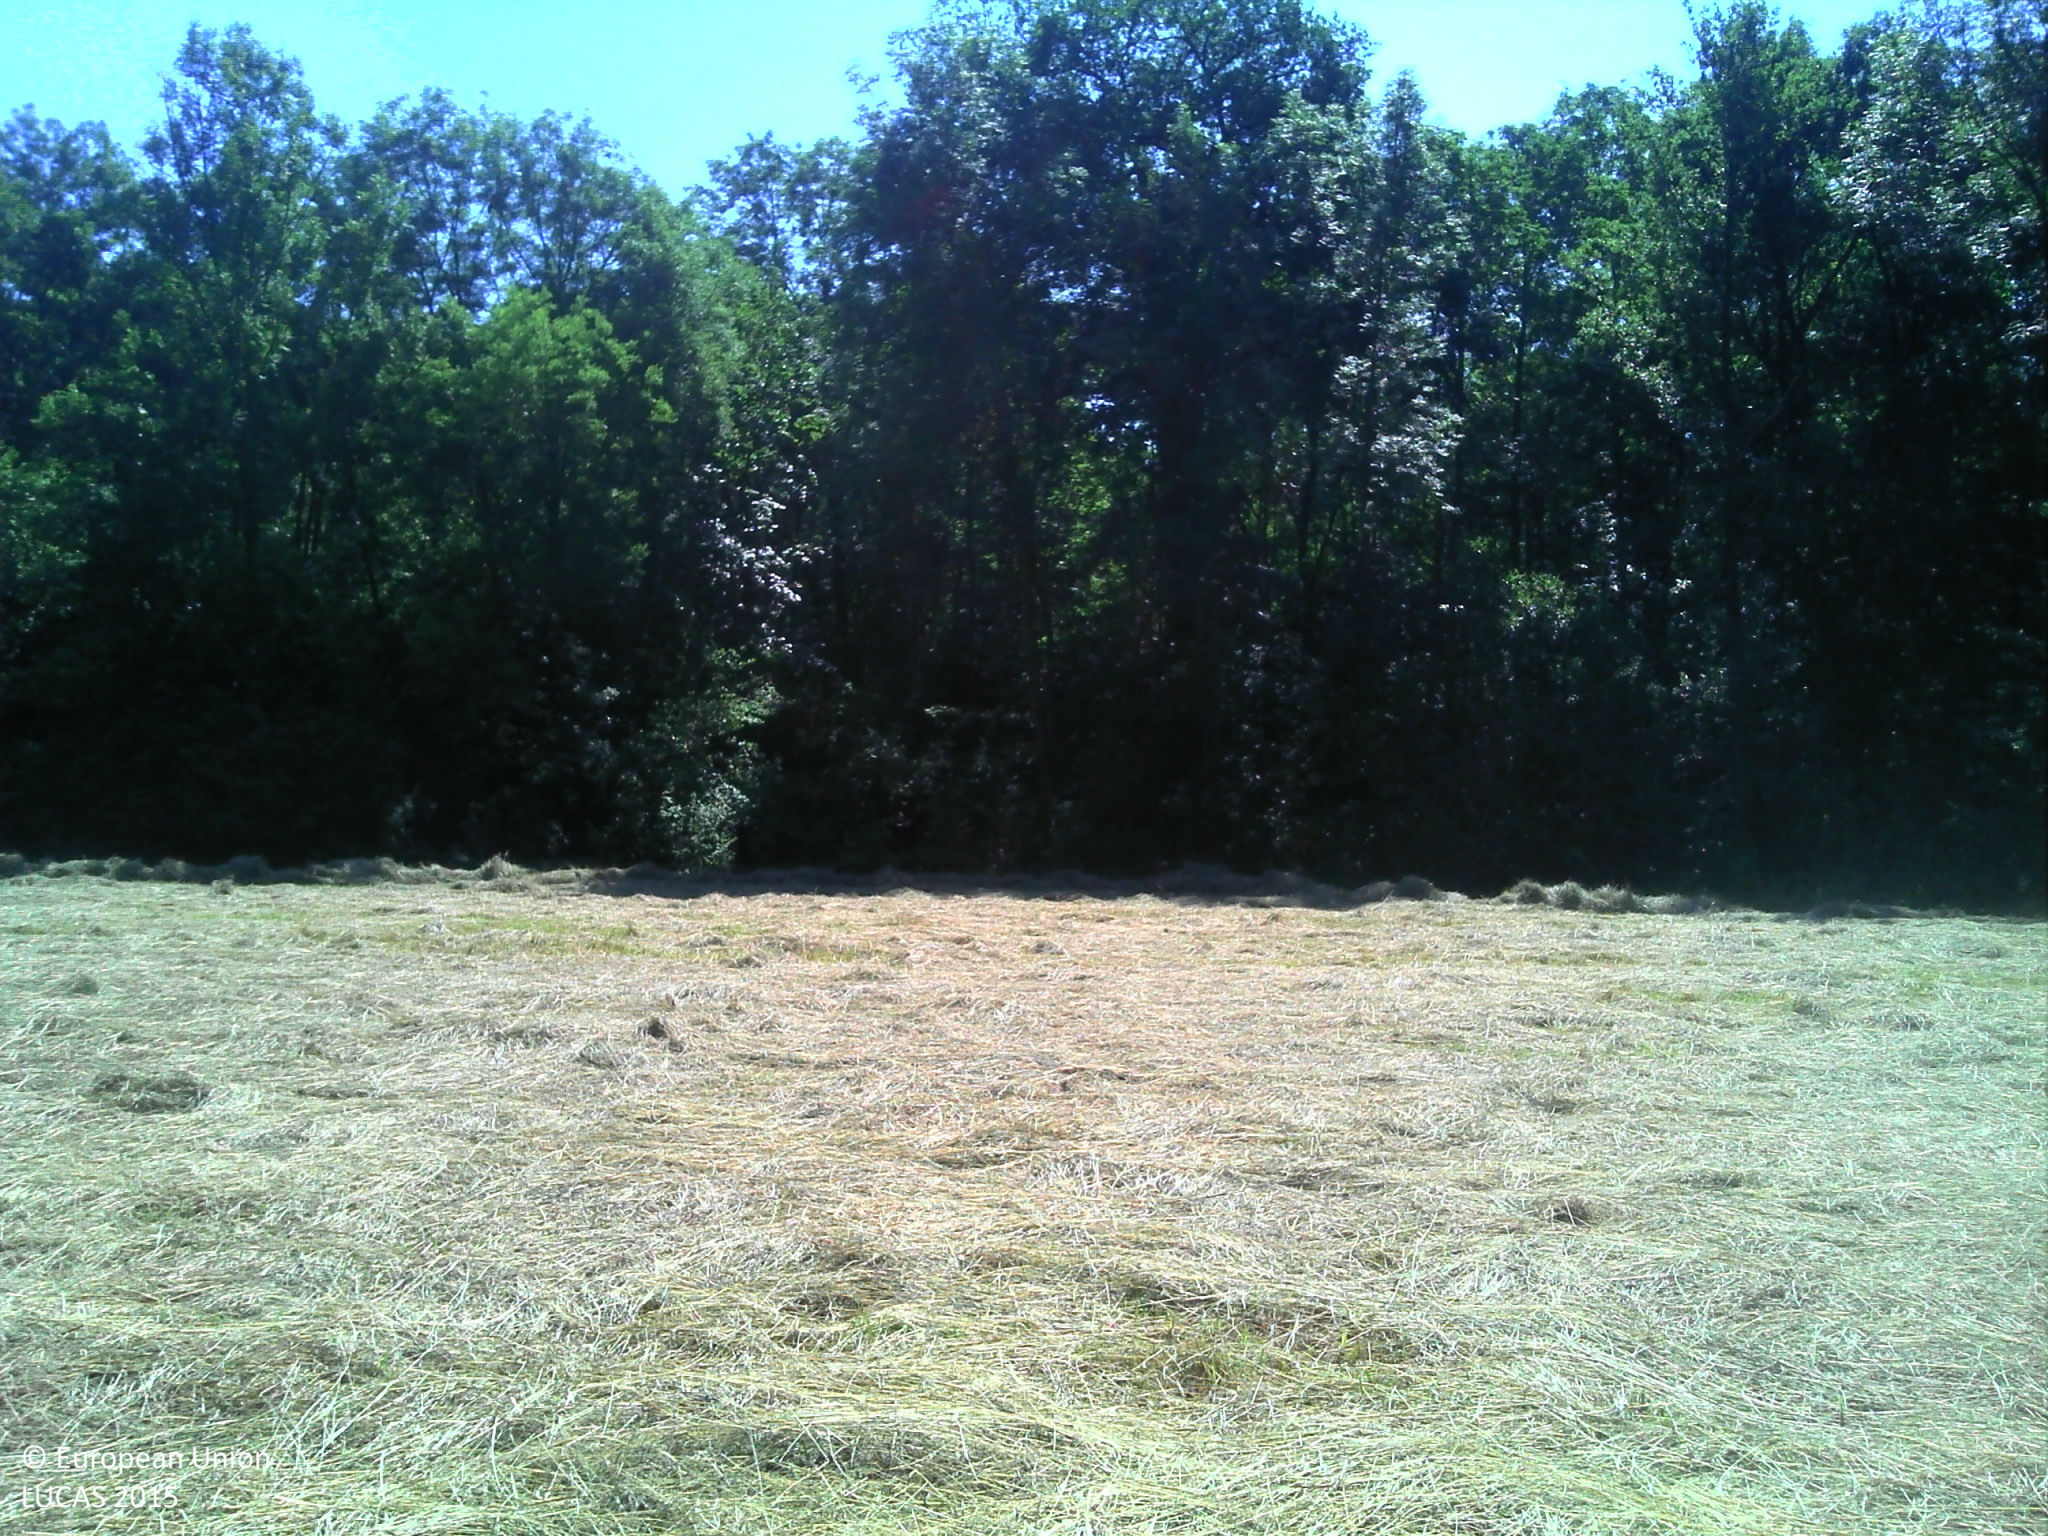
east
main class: Grassland
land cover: Grassland without tree/shrub cover
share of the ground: > 75 %
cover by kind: herbaceous plants 100 %
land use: Agriculture (excluding fallow land and kitchen gardens)
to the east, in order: Grassland without tree/shrub cover; Broadleaved woodland; Inland fresh running water; Broadleaved woodland; Tracks; Broadleaved woodland
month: June
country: FR
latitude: 48.3968
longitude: 7.6643
